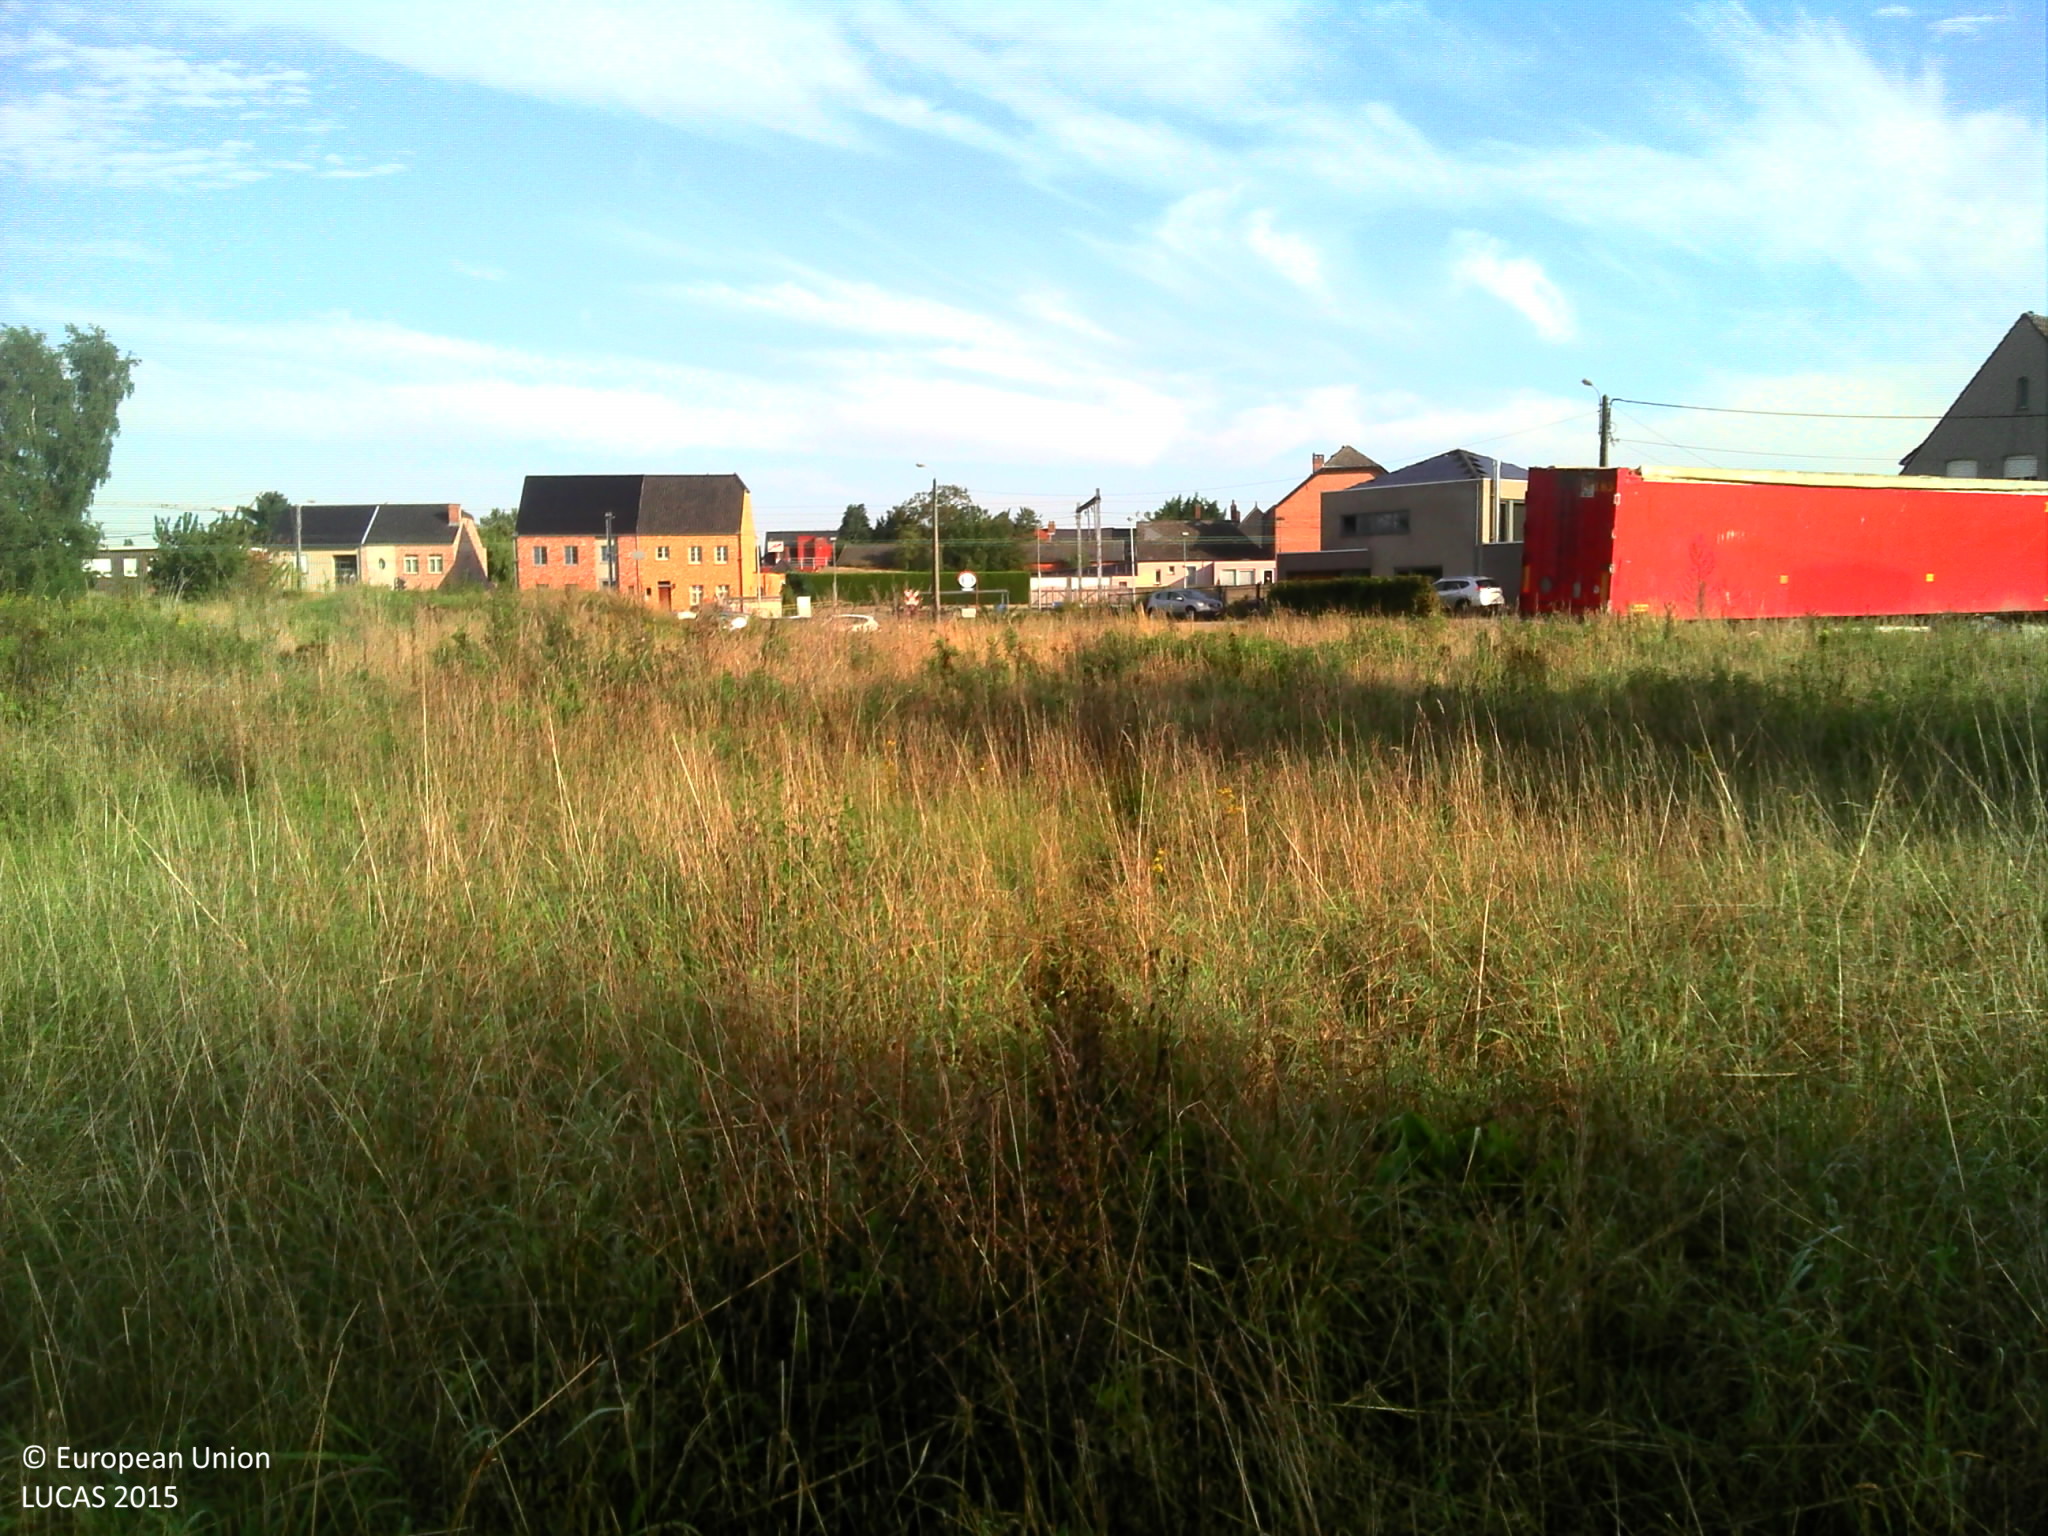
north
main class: Grassland
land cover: Grassland without tree/shrub cover
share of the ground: > 75 %
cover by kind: herbaceous plants 100 %
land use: Semi-natural and natural areas not in use
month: September
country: BE
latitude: 51.1585
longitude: 4.6628
